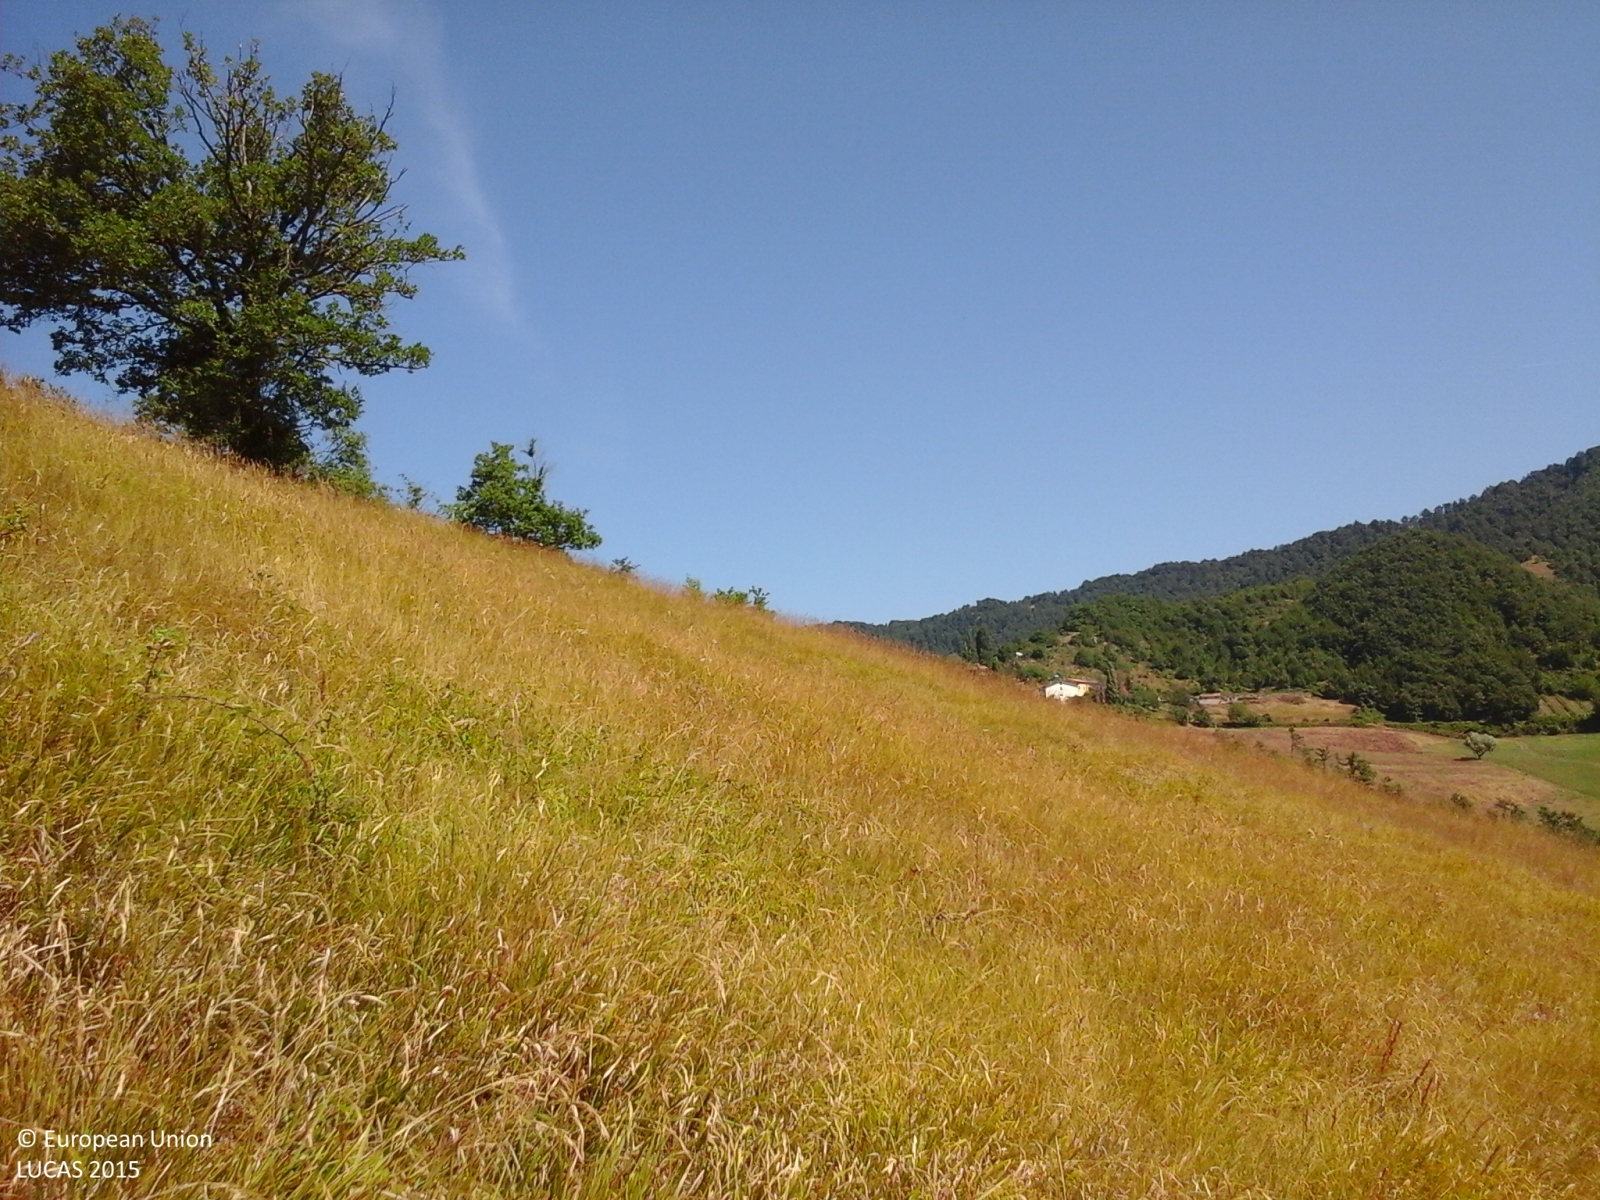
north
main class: Grassland
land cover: Grassland without tree/shrub cover
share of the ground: > 75 %
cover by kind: herbaceous plants 100 %
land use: Agriculture (excluding fallow land and kitchen gardens)
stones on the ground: 10 - 25 %
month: August
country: IT
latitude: 43.4528
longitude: 12.5513
